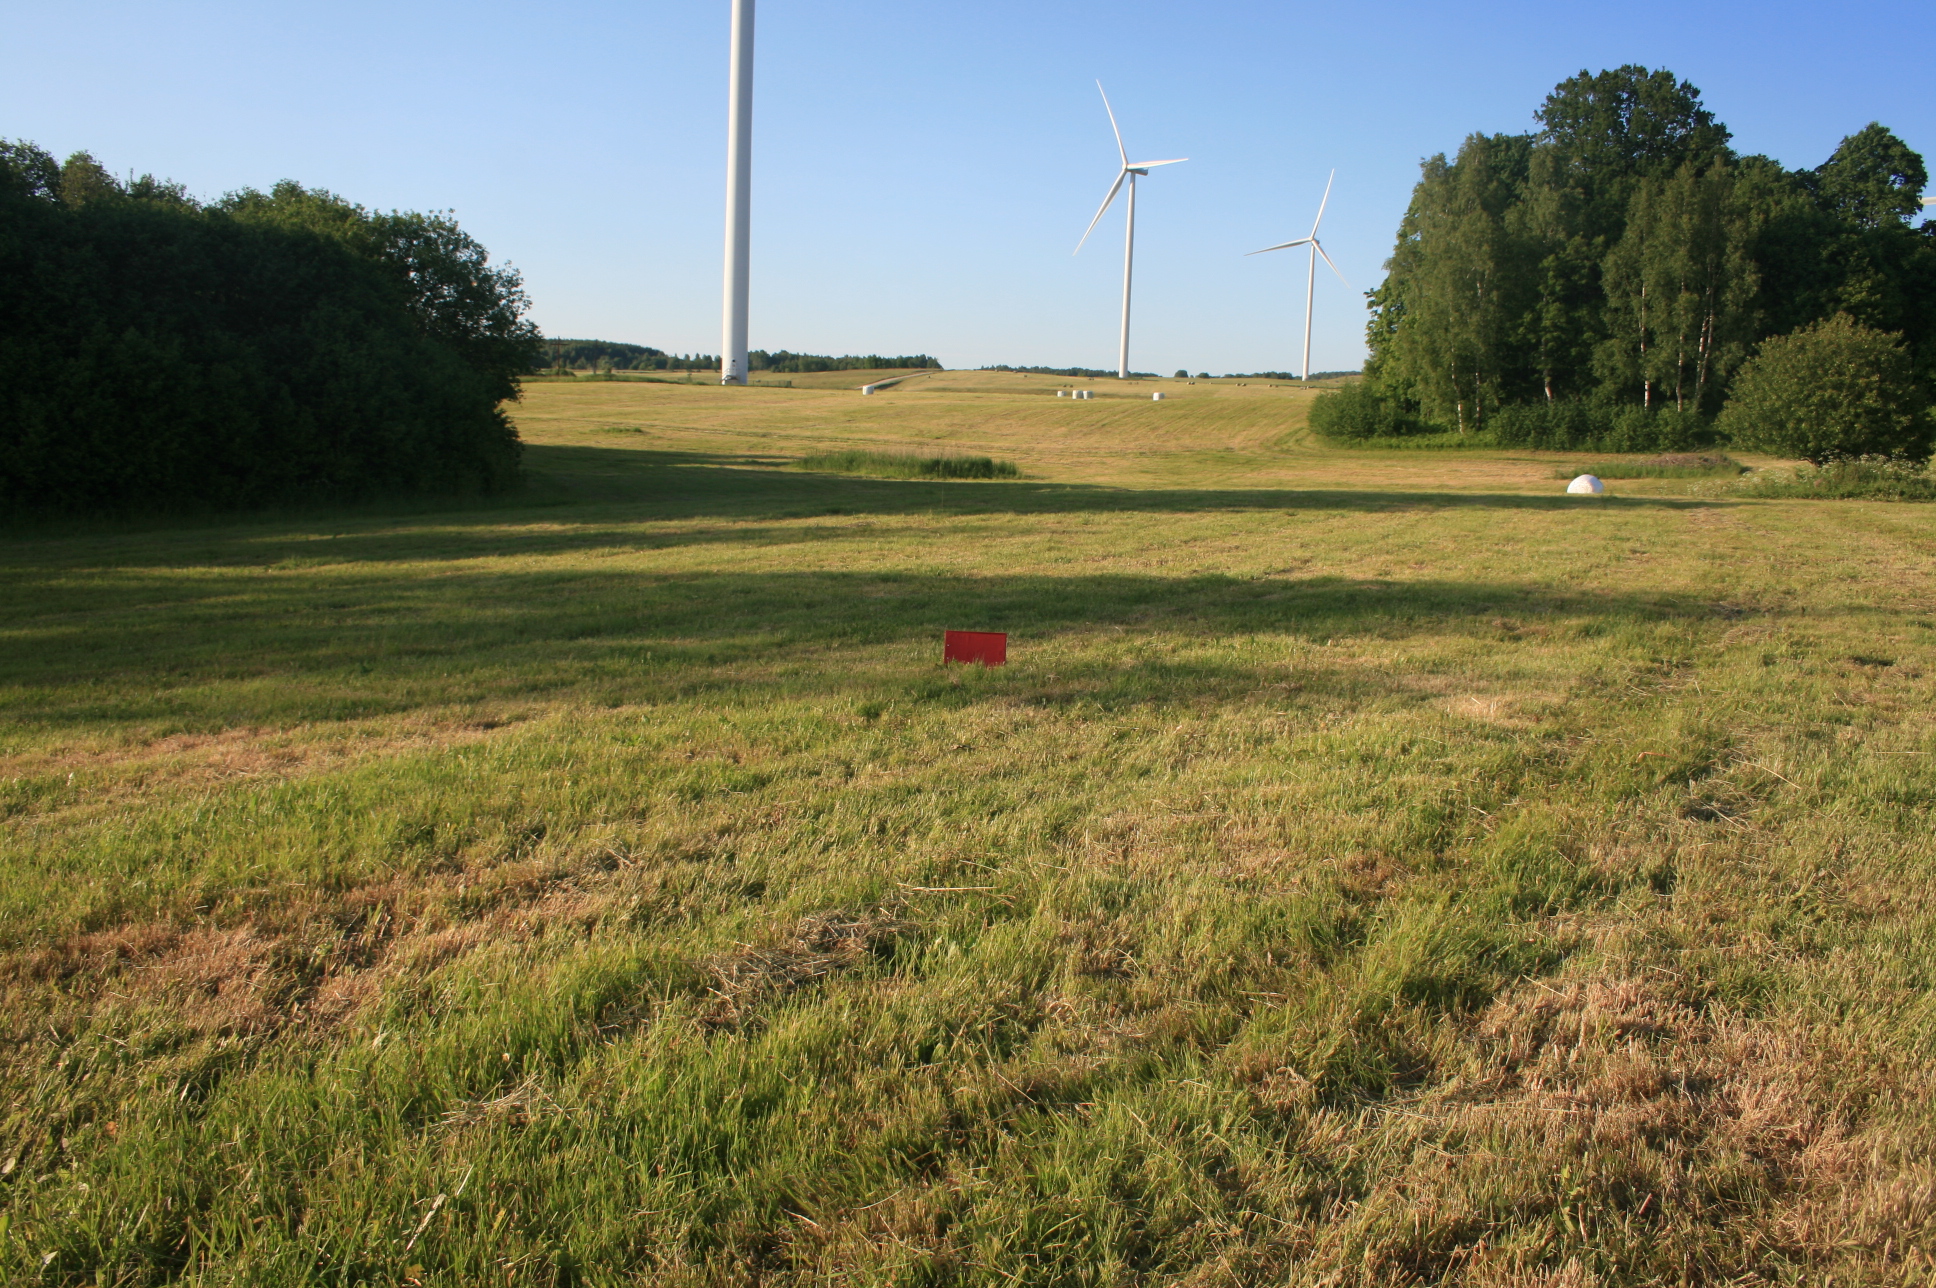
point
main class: Grassland
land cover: Grassland without tree/shrub cover
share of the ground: > 75 %
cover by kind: herbaceous plants 100 %
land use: Agriculture (excluding fallow land and kitchen gardens)
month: June
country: LT
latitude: 55.5678
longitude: 22.1871
